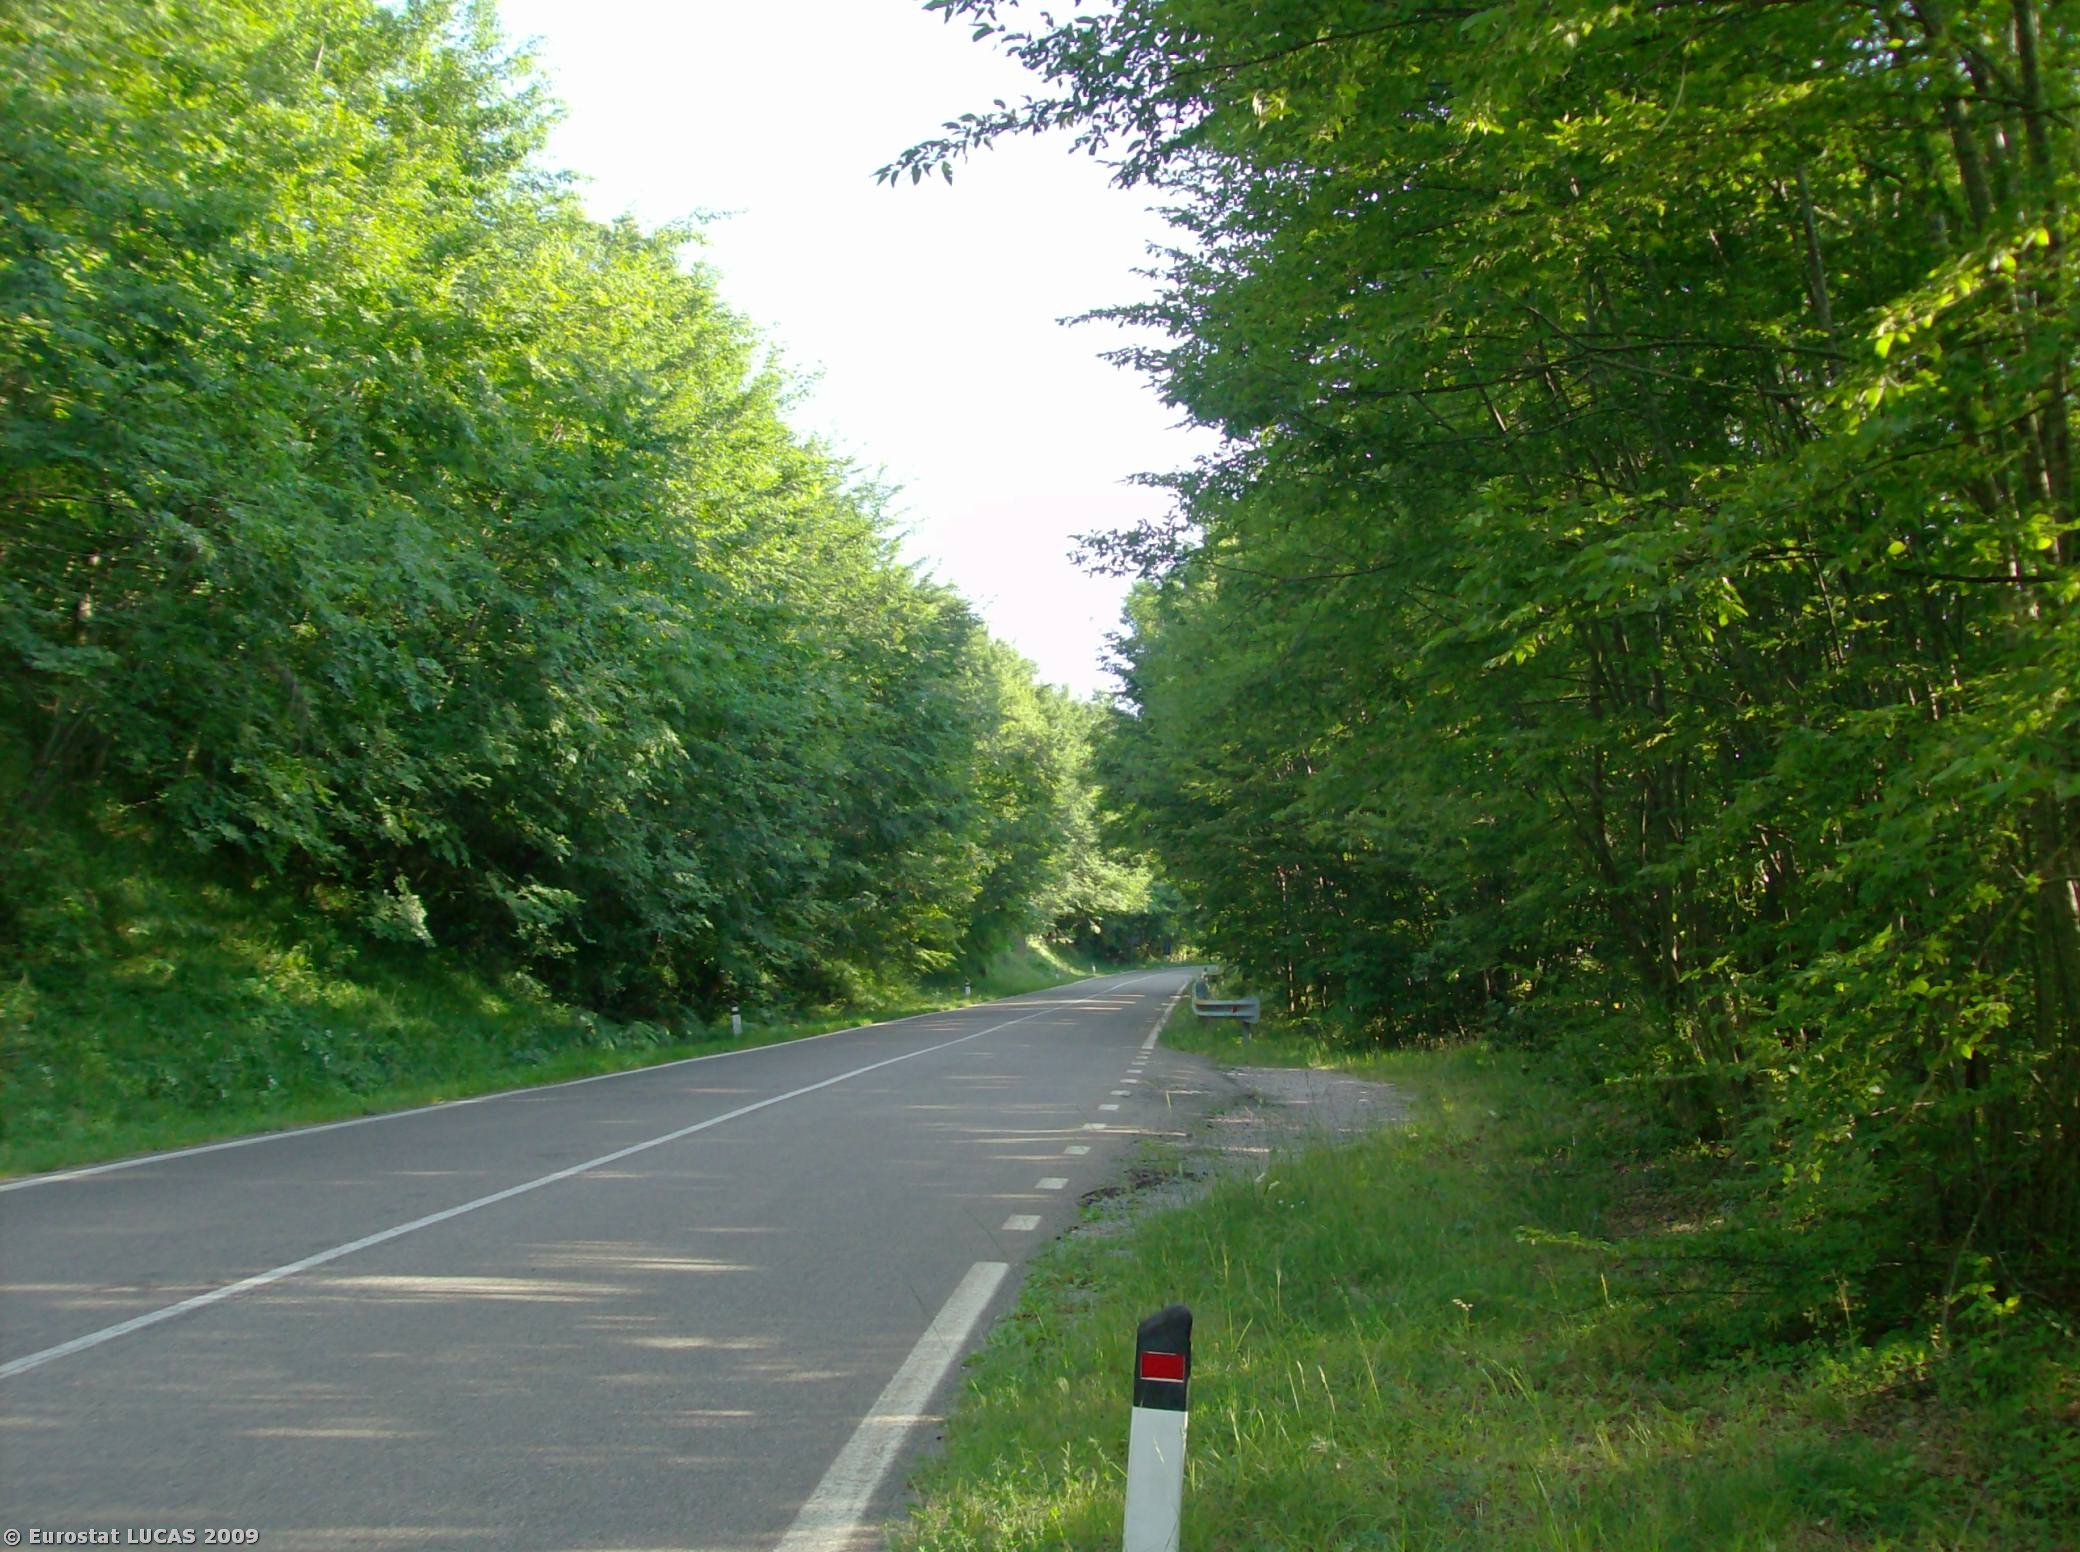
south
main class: Woodland
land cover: Broadleaved woodland
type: thermophilous deciduous forest
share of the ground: > 75 %
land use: Forestry
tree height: > 5 m
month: June
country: IT
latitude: 42.8040
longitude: 11.5967
